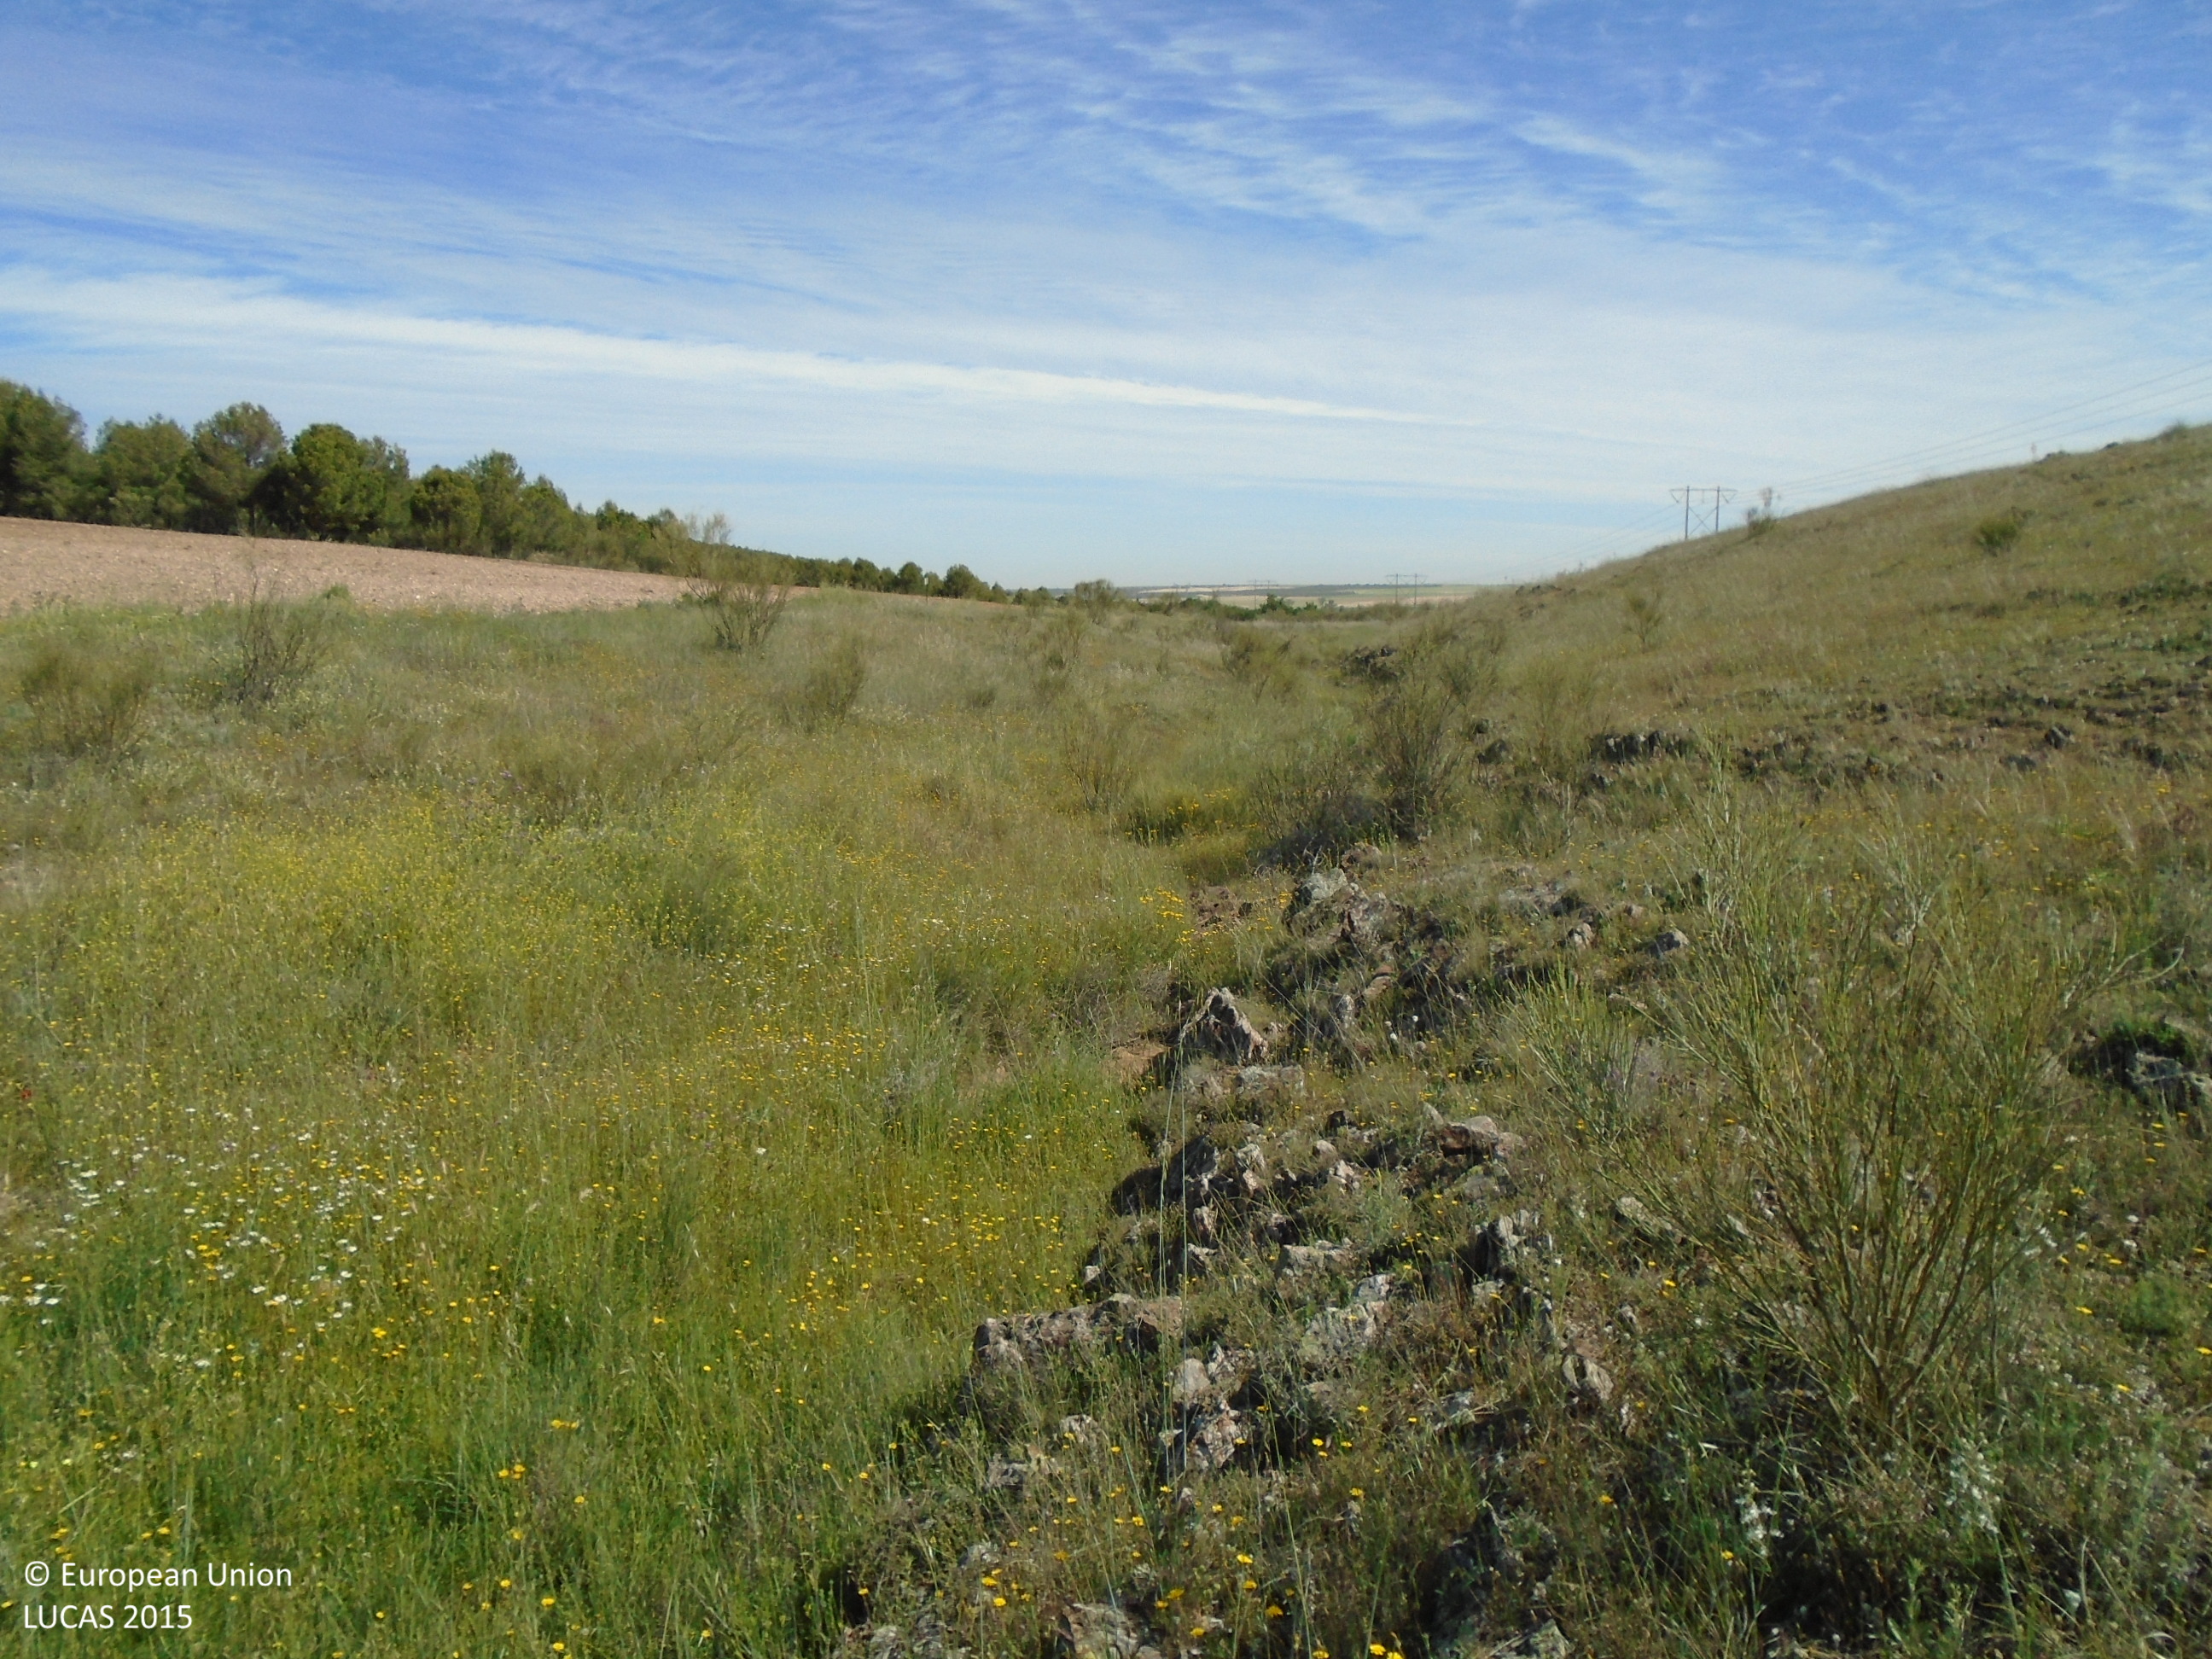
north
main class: Grassland
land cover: Grassland without tree/shrub cover
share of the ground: > 75 %
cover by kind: herbaceous plants 90 %, shrubs 5 %, consolidated bare surface 5 %
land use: Semi-natural and natural areas not in use
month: May
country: ES
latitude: 39.6417
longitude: -3.6248
